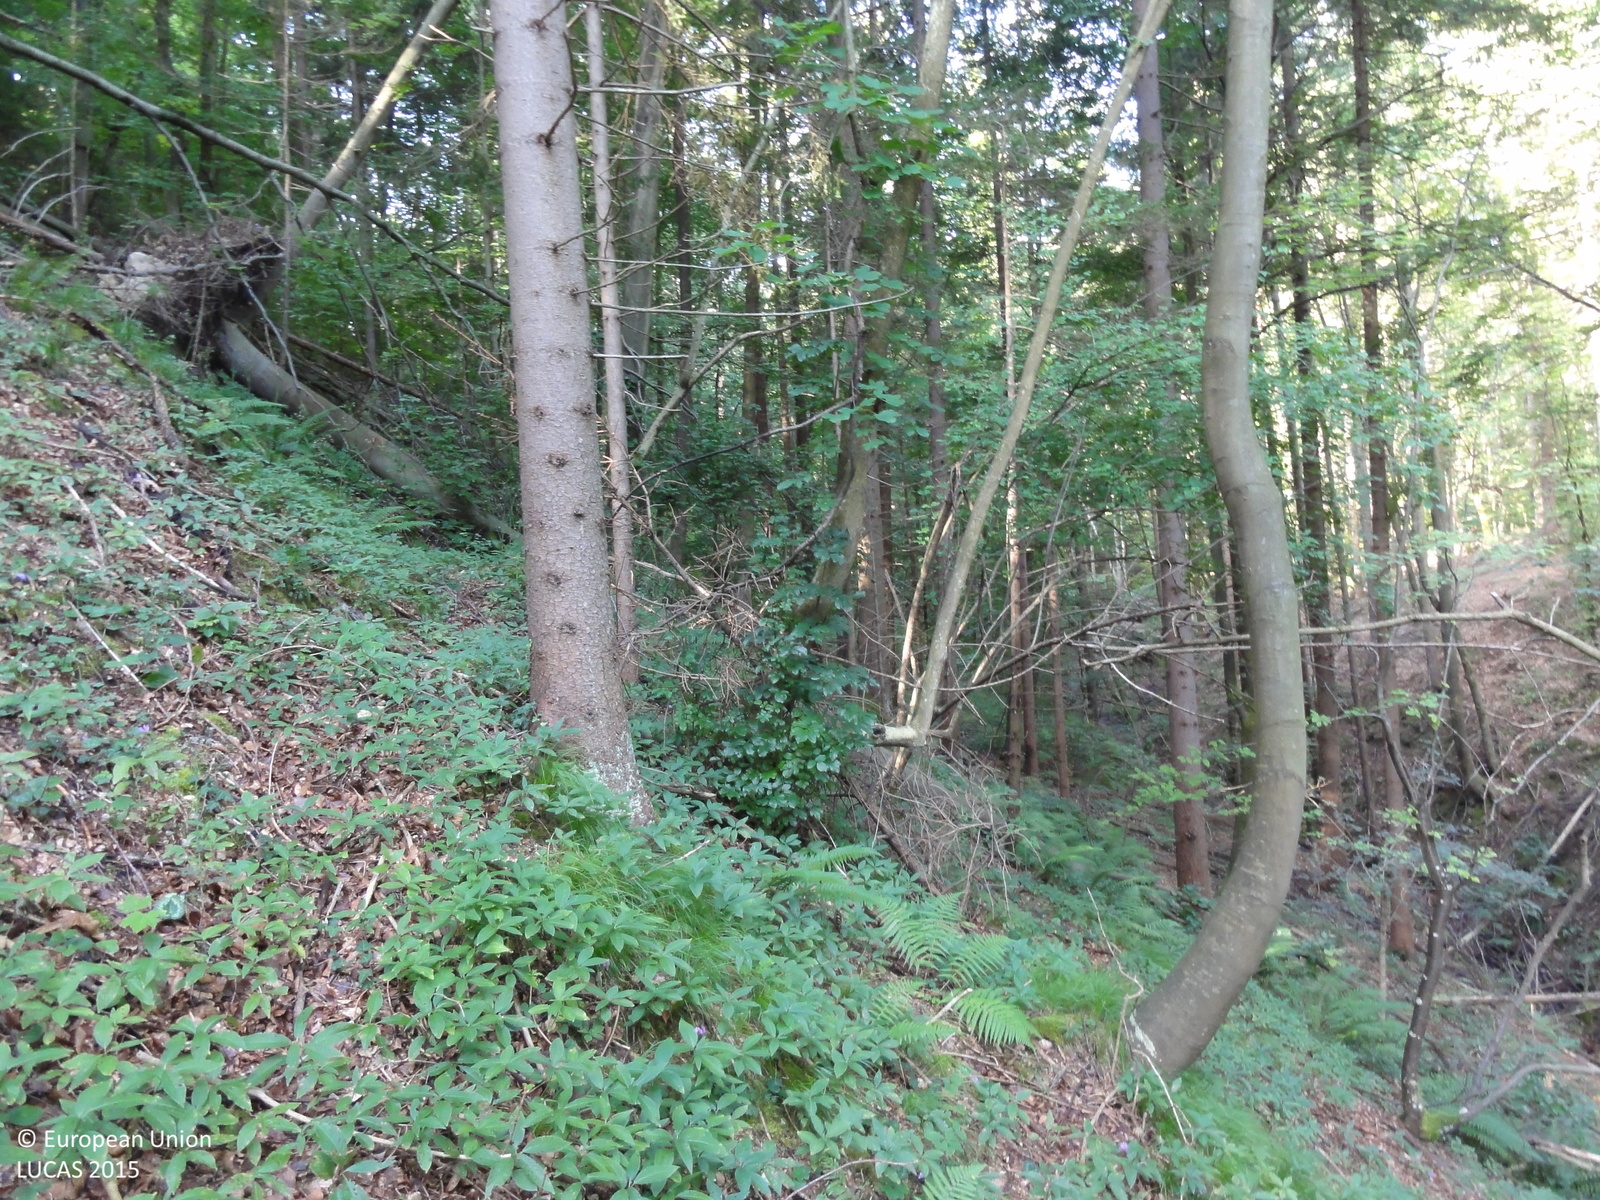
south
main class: Woodland
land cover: Spruce dominated mixed woodland
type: mountainous beech forest
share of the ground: > 75 %
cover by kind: broadleaved forest trees 50 %, coniferous forest trees 25 %, herbaceous plants 20 %, shrubs 5 %
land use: Forestry
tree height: > 5 m
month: August
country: SI
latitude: 46.3173
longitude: 15.1535
